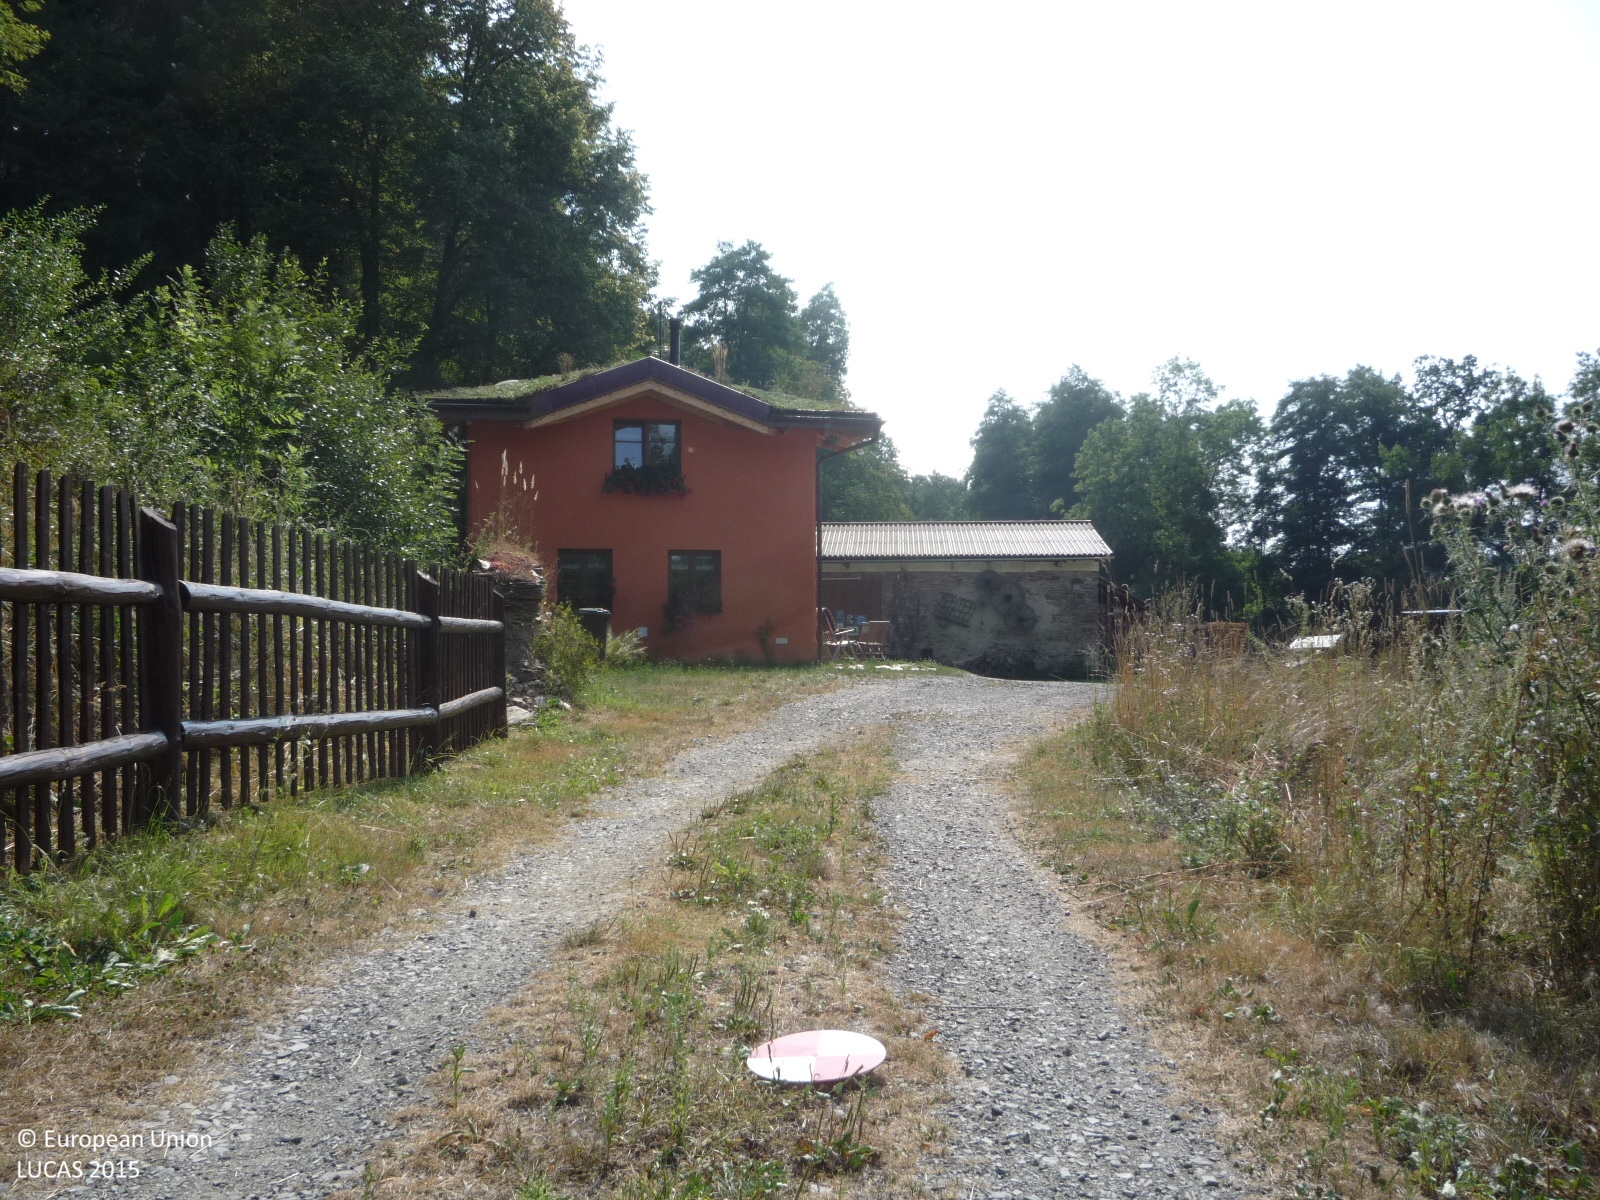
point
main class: Grassland
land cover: Spontaneously vegetated surfaces
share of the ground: > 75 %
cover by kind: herbaceous plants 100 %
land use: Semi-natural and natural areas not in use
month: August
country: CZ
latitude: 49.9164
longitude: 14.4721
